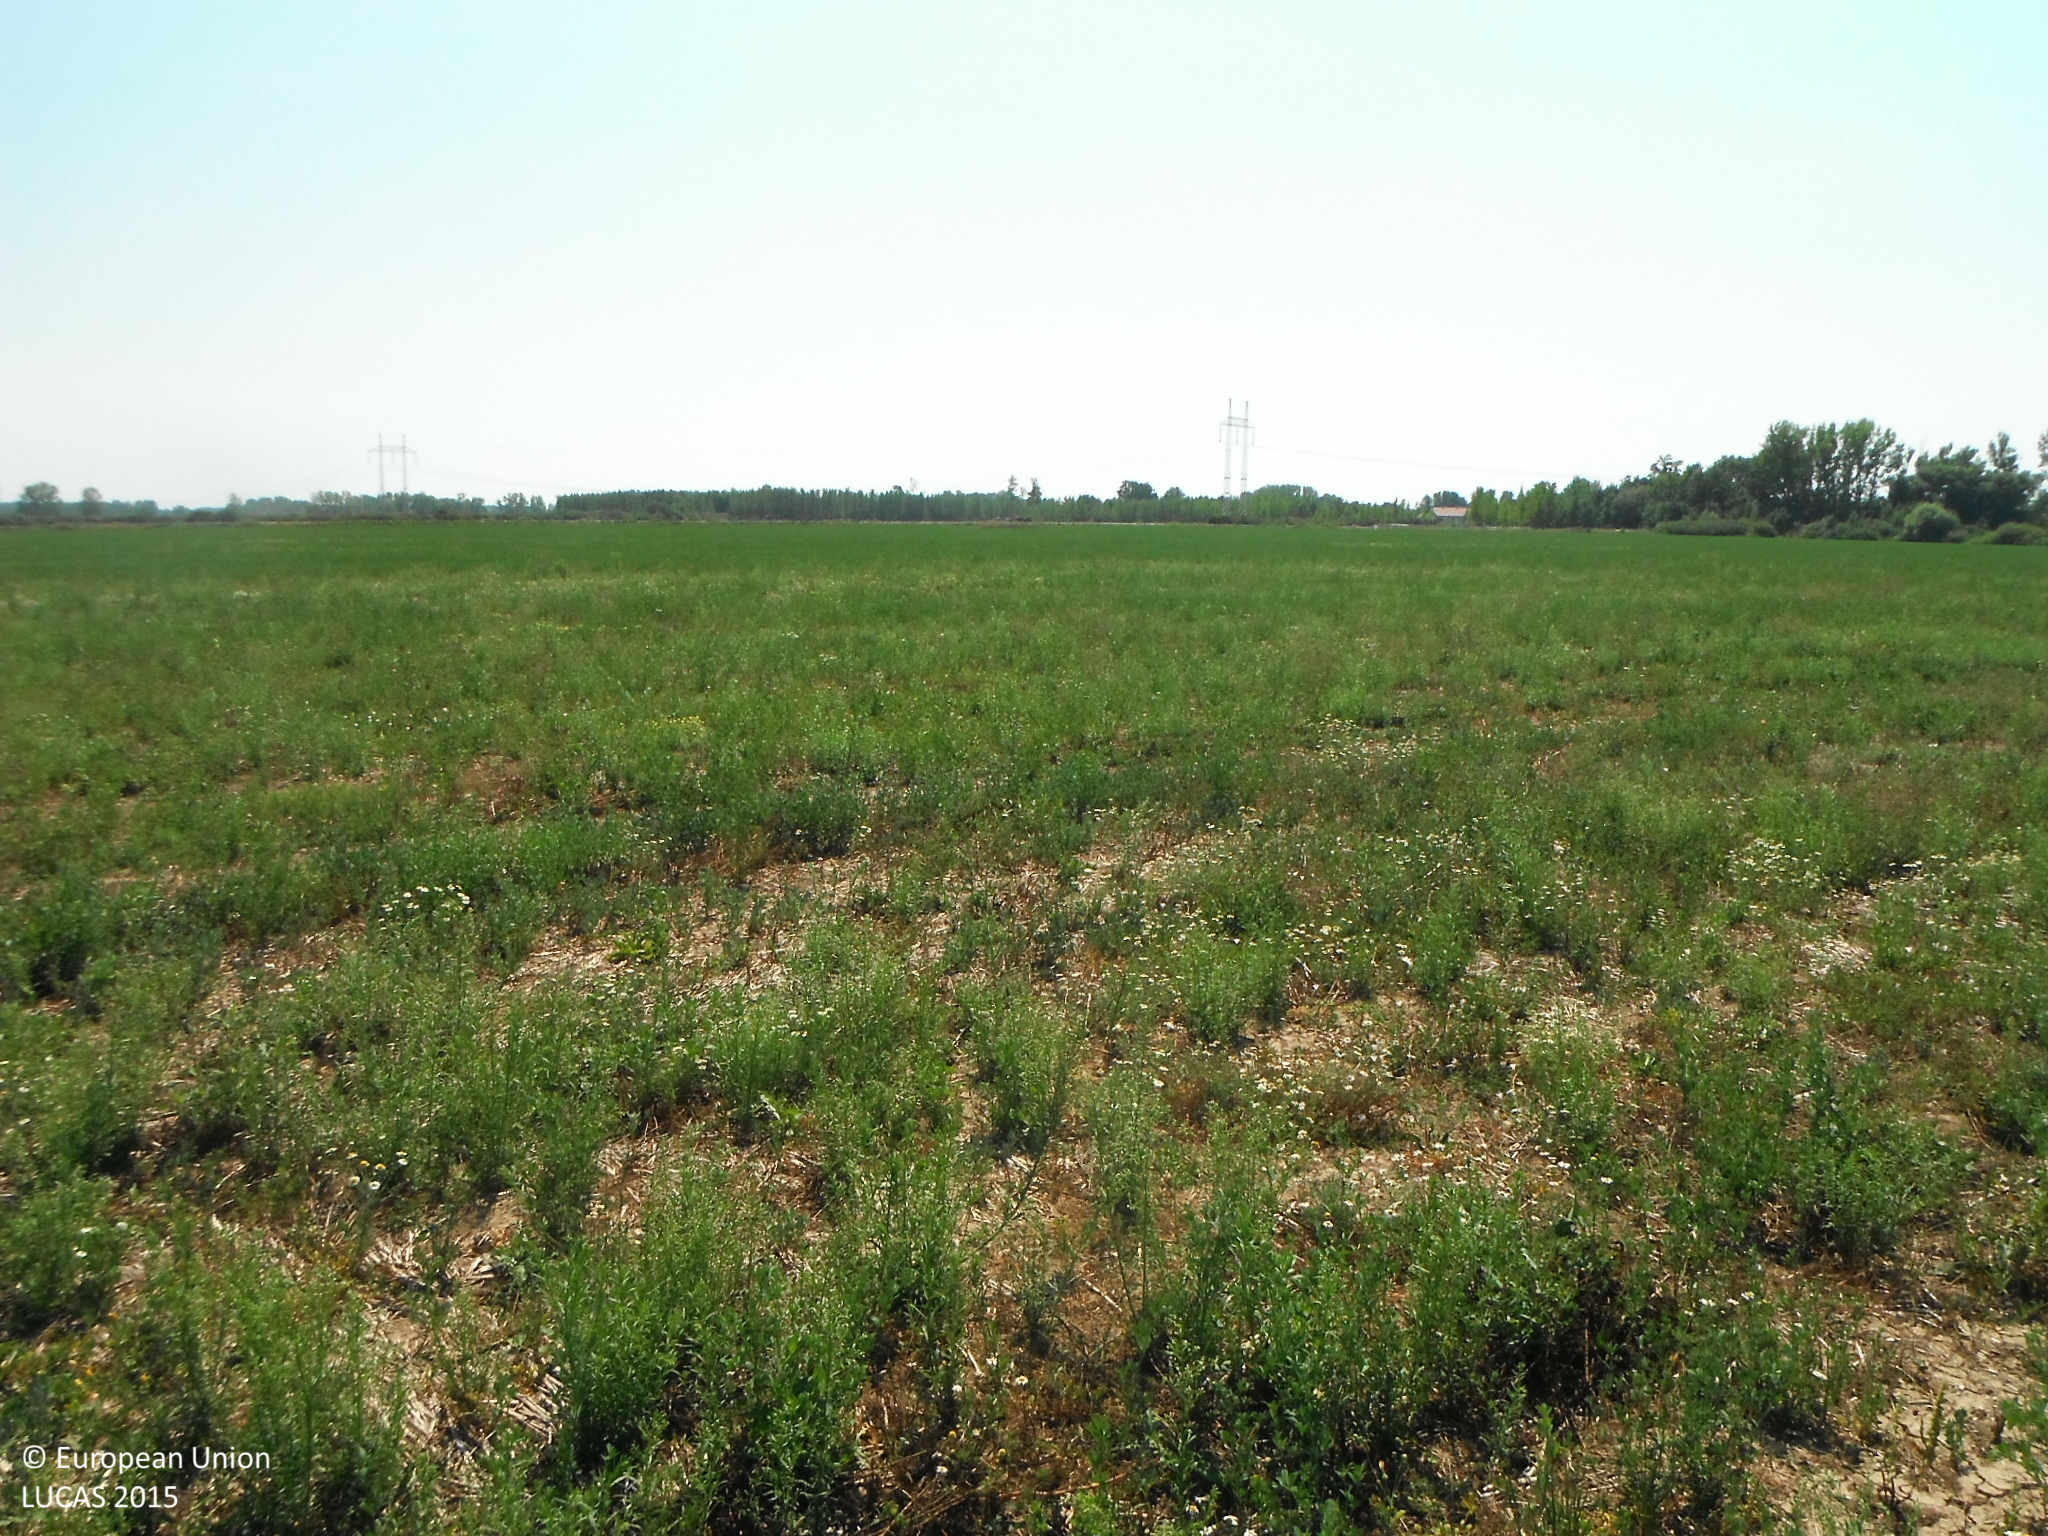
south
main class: Cropland
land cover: Lucerne
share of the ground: > 75 %
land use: Agriculture (excluding fallow land and kitchen gardens)
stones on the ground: < 10 %
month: August
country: SK
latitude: 48.6461
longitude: 21.9297
